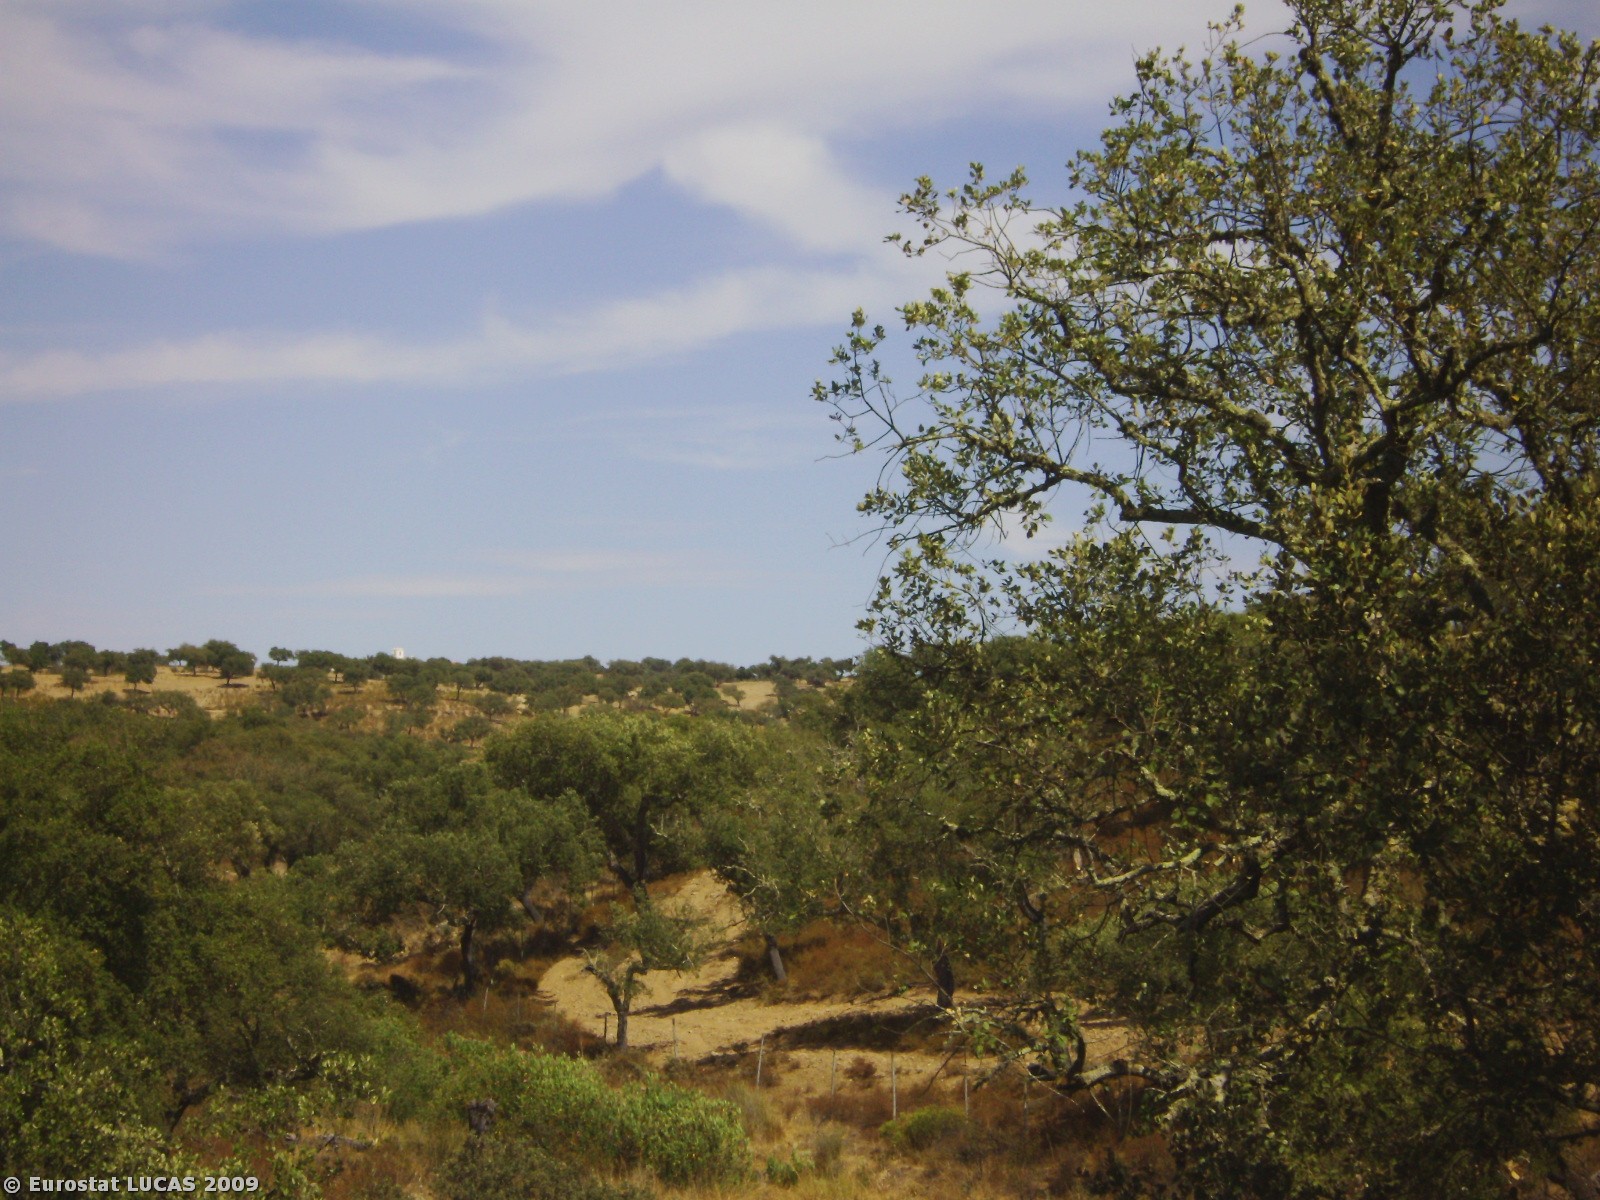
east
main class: Woodland
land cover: Broadleaved woodland
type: broadleaved evergreen forest
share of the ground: 50 - 75 %
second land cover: Shrubland with sparse tree cover
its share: 50 - 75 %
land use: Forestry
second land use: Unused
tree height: > 5 m
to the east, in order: Broadleaved woodland; Shrubland with sparse tree cover; Broadleaved woodland; Shrubland without tree cover; Abandoned hedges; Fences; Bare land; Broadleaved woodland; Bare land; Fences; Broadleaved woodland
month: August
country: PT
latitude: 38.0668
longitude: -7.1211
